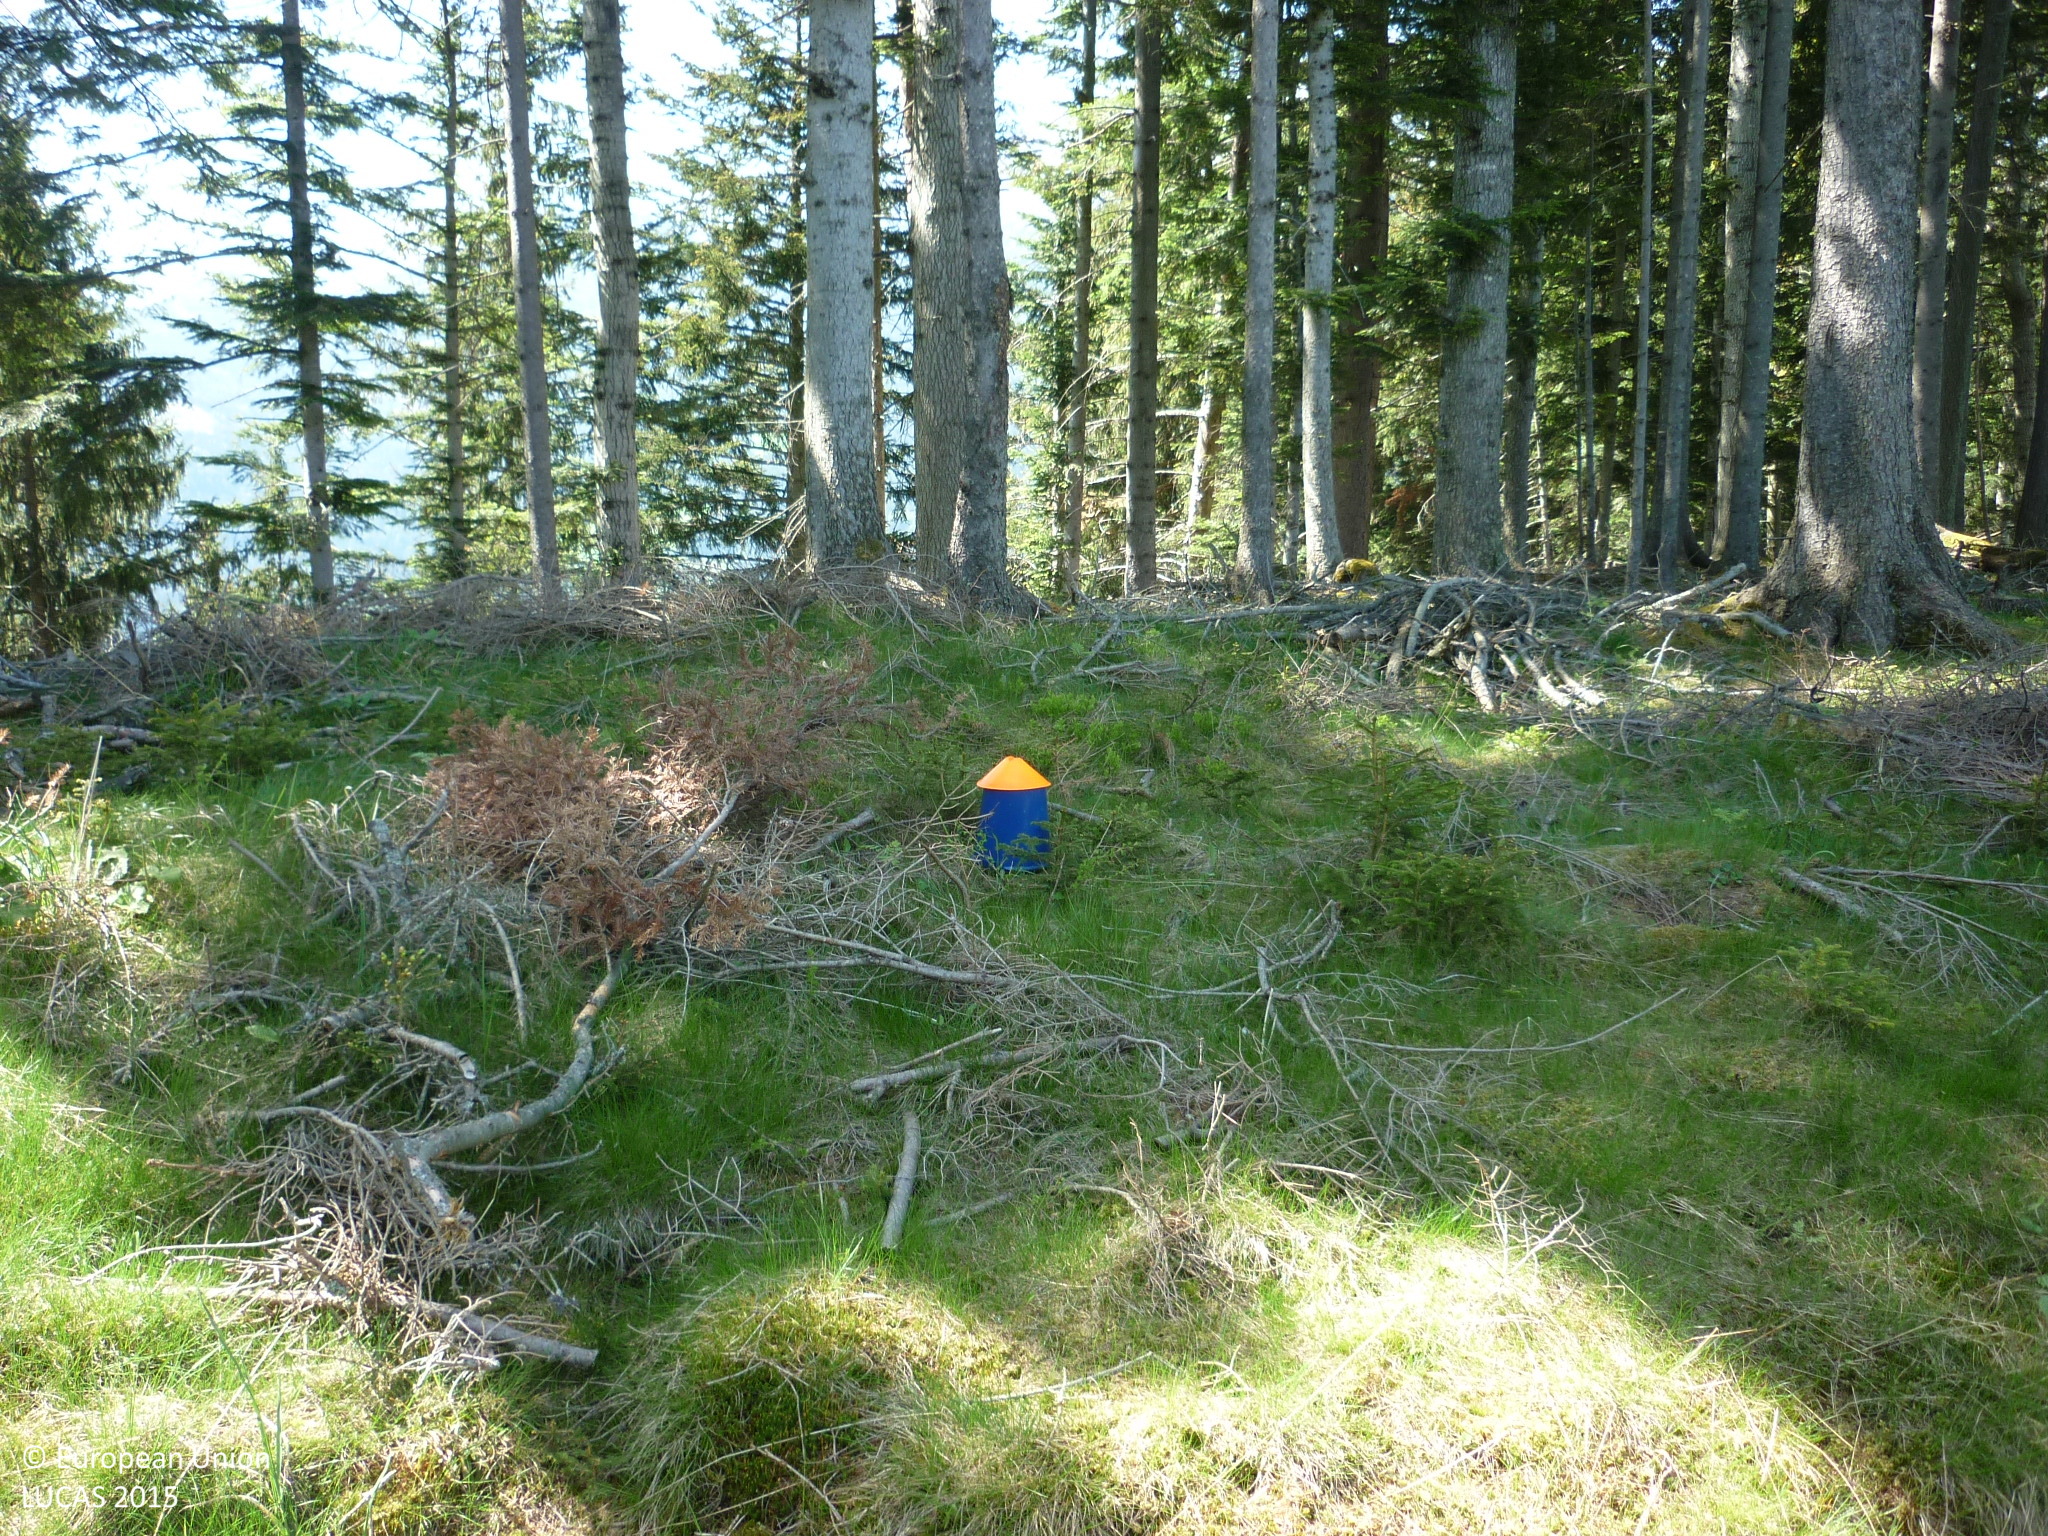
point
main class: Grassland
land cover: Grassland with sparse tree/shrub cover
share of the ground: > 75 %
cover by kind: herbaceous plants 90 %, coniferous forest trees 5 %, lichens and mosses 5 %
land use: Forestry
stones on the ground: < 10 %
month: May
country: AT
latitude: 47.5210
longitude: 14.4481
